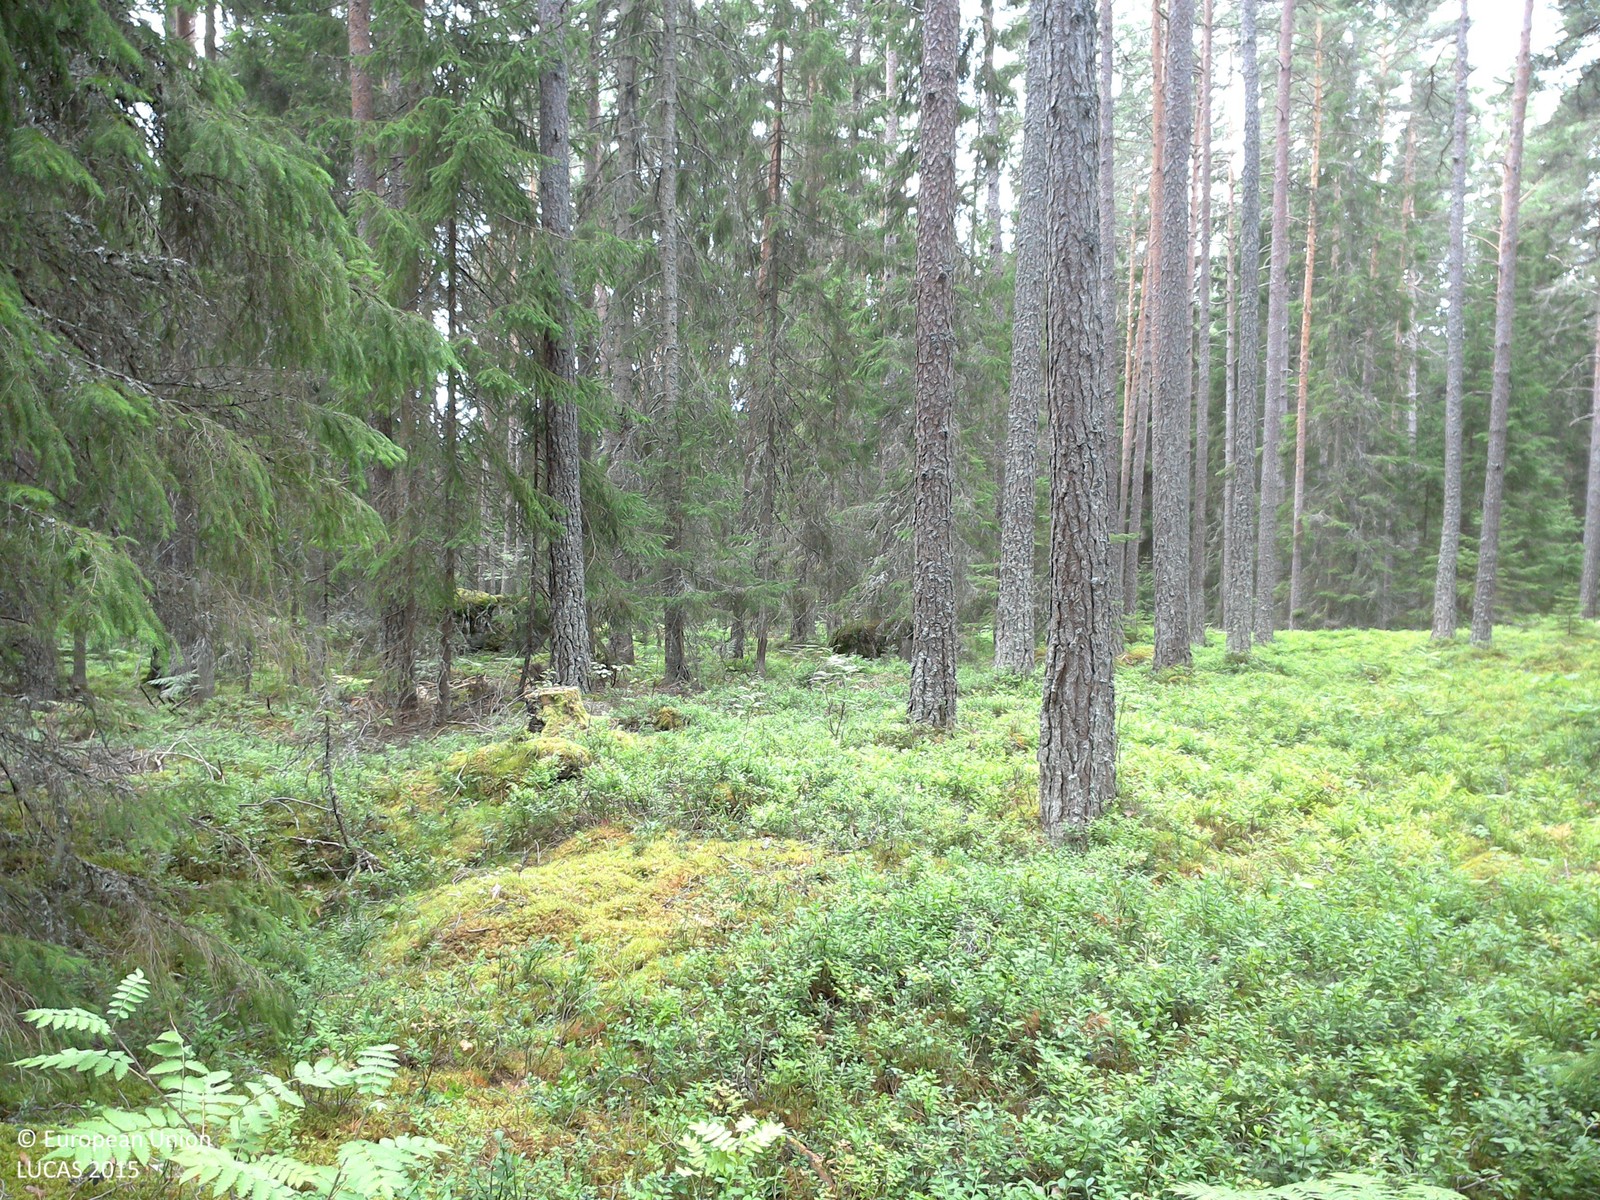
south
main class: Woodland
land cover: Pine dominated coniferous woodland
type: boreal forest
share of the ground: 50 - 75 %
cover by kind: coniferous forest trees 50 %, shrubs 30 %, herbaceous plants 10 %, lichens and mosses 10 %
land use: Forestry
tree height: > 5 m
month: July
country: SE
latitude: 57.7594
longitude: 16.0308
